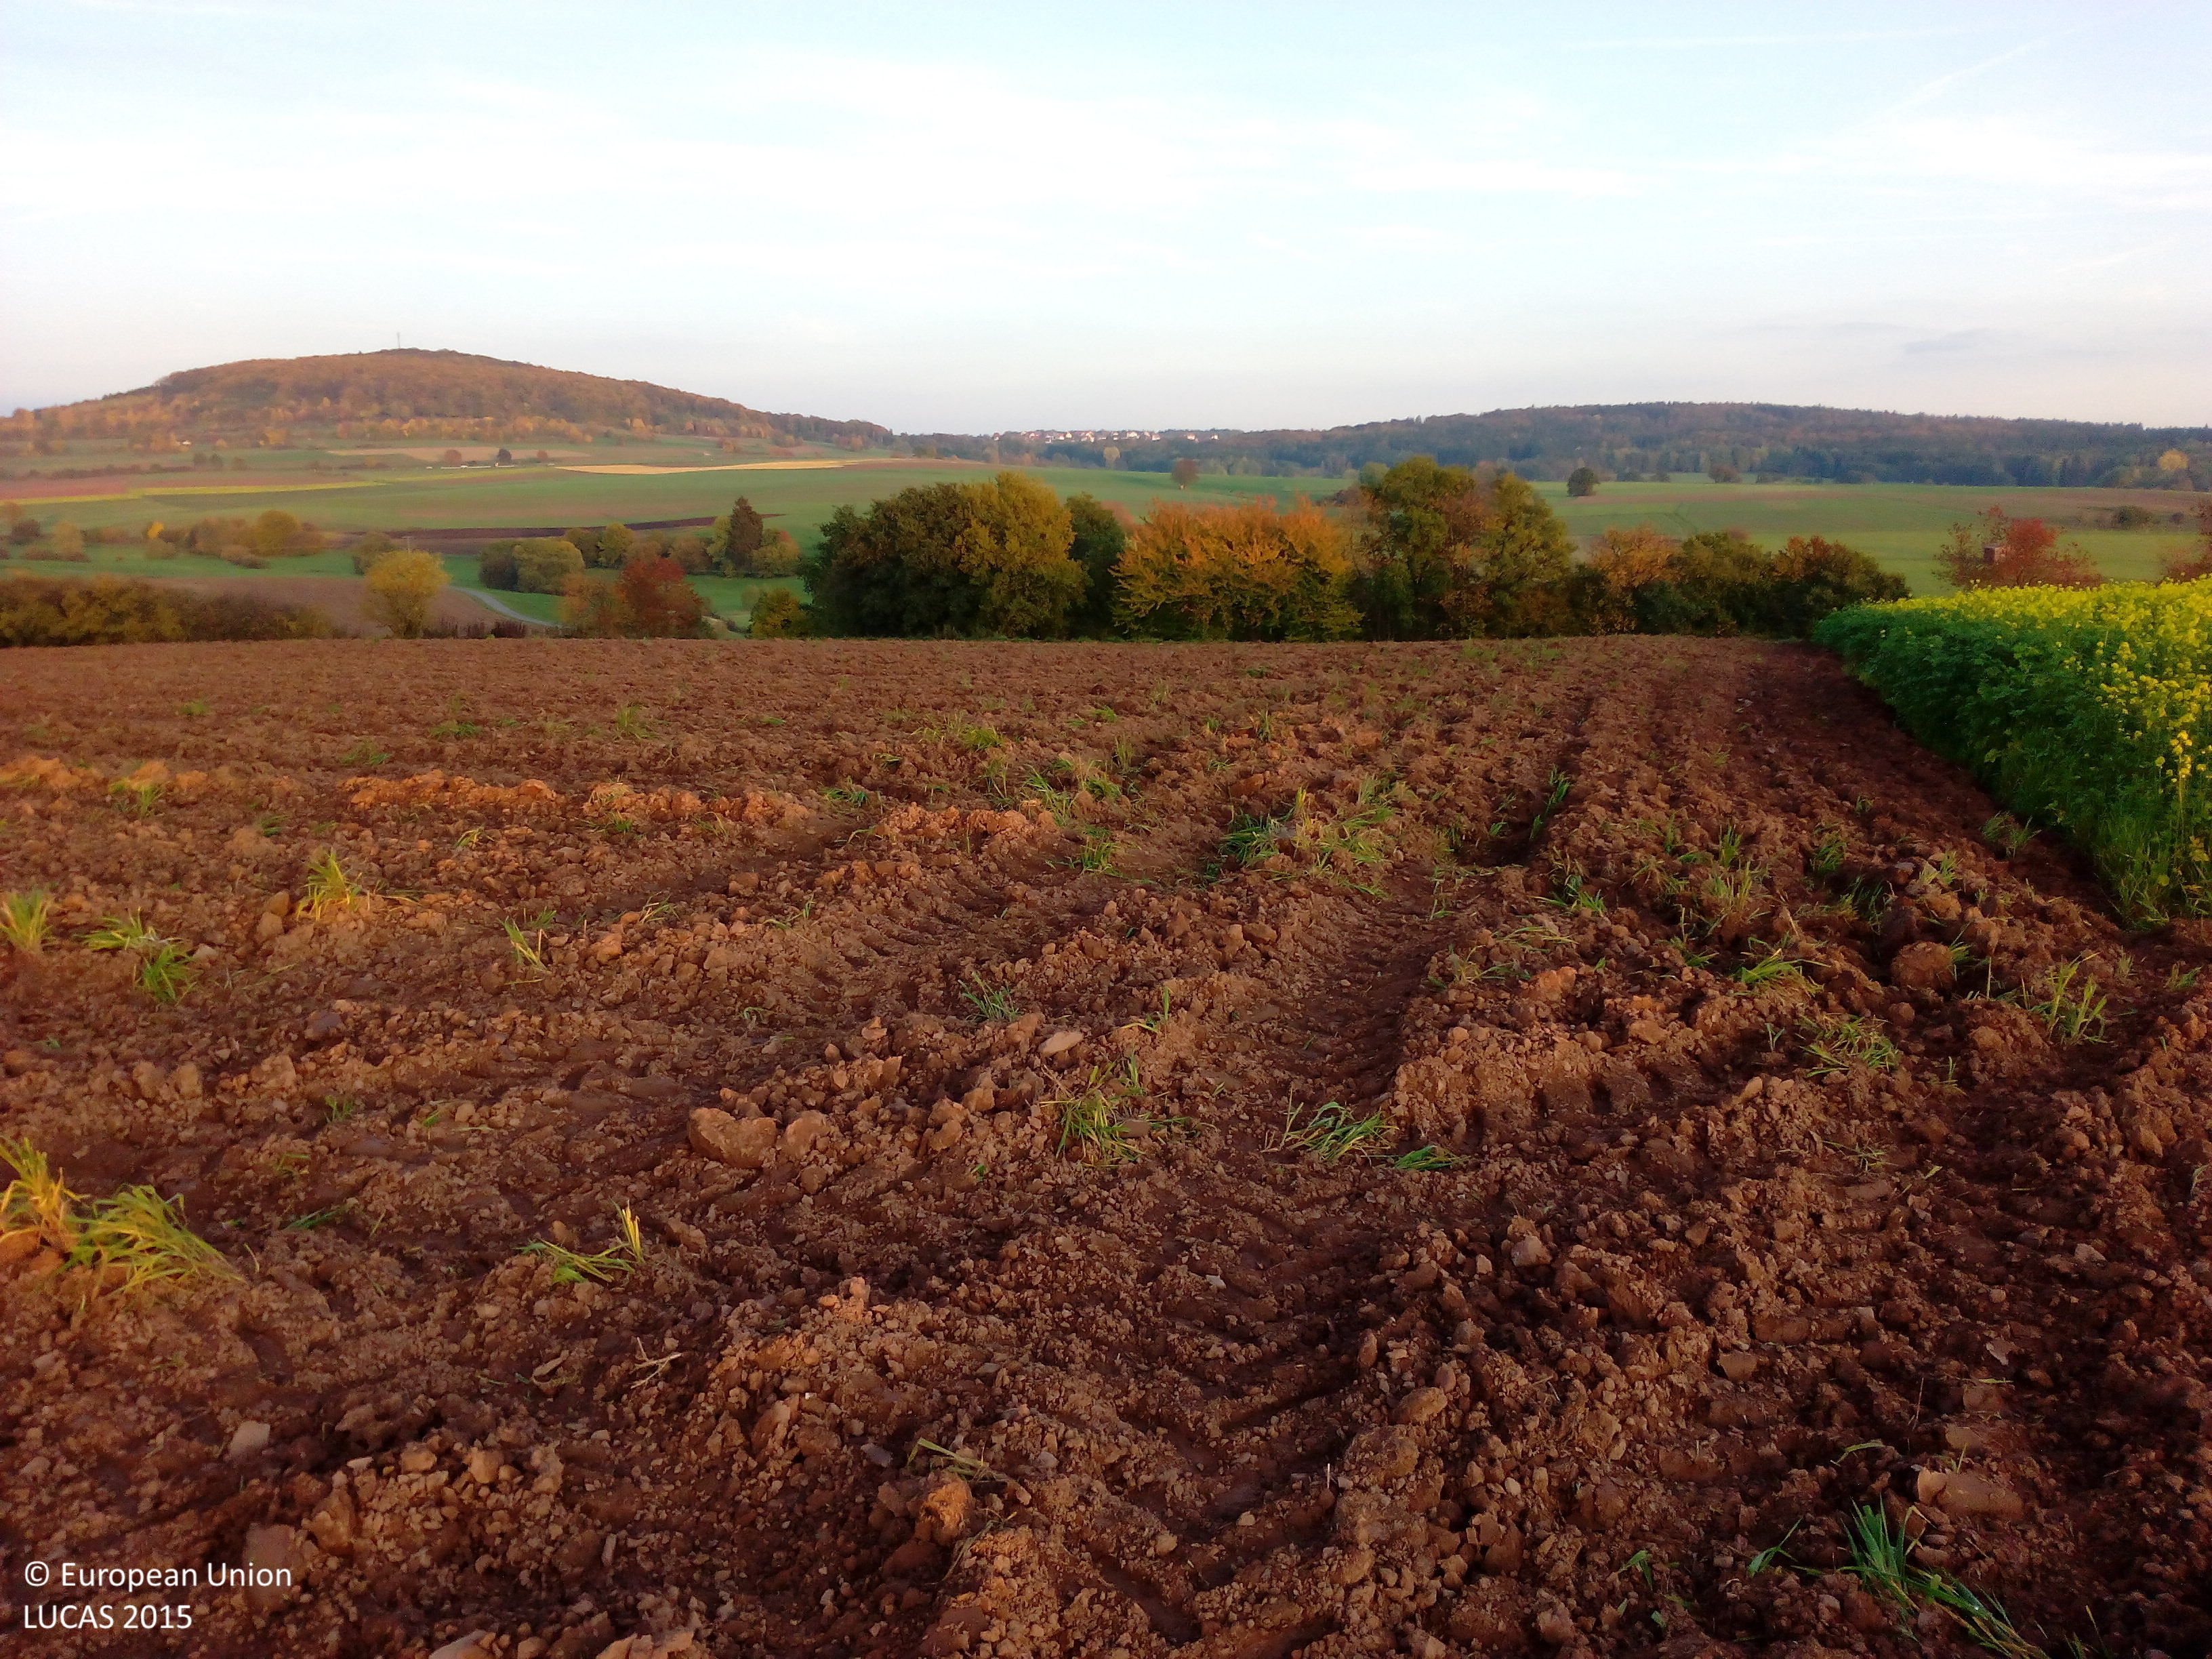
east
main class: Cropland
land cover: Barley
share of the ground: < 10 %
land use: Agriculture (excluding fallow land and kitchen gardens)
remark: Tilled/Sowed
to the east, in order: Barley; Grass margins; Other bare soil; Broadleaved woodland; Temporary grasslands; Broadleaved woodland; Grassland without tree/shrub cover; Spontaneously vegetated surfaces; Common wheat
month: October
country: DE
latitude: 50.2561
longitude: 9.8458
